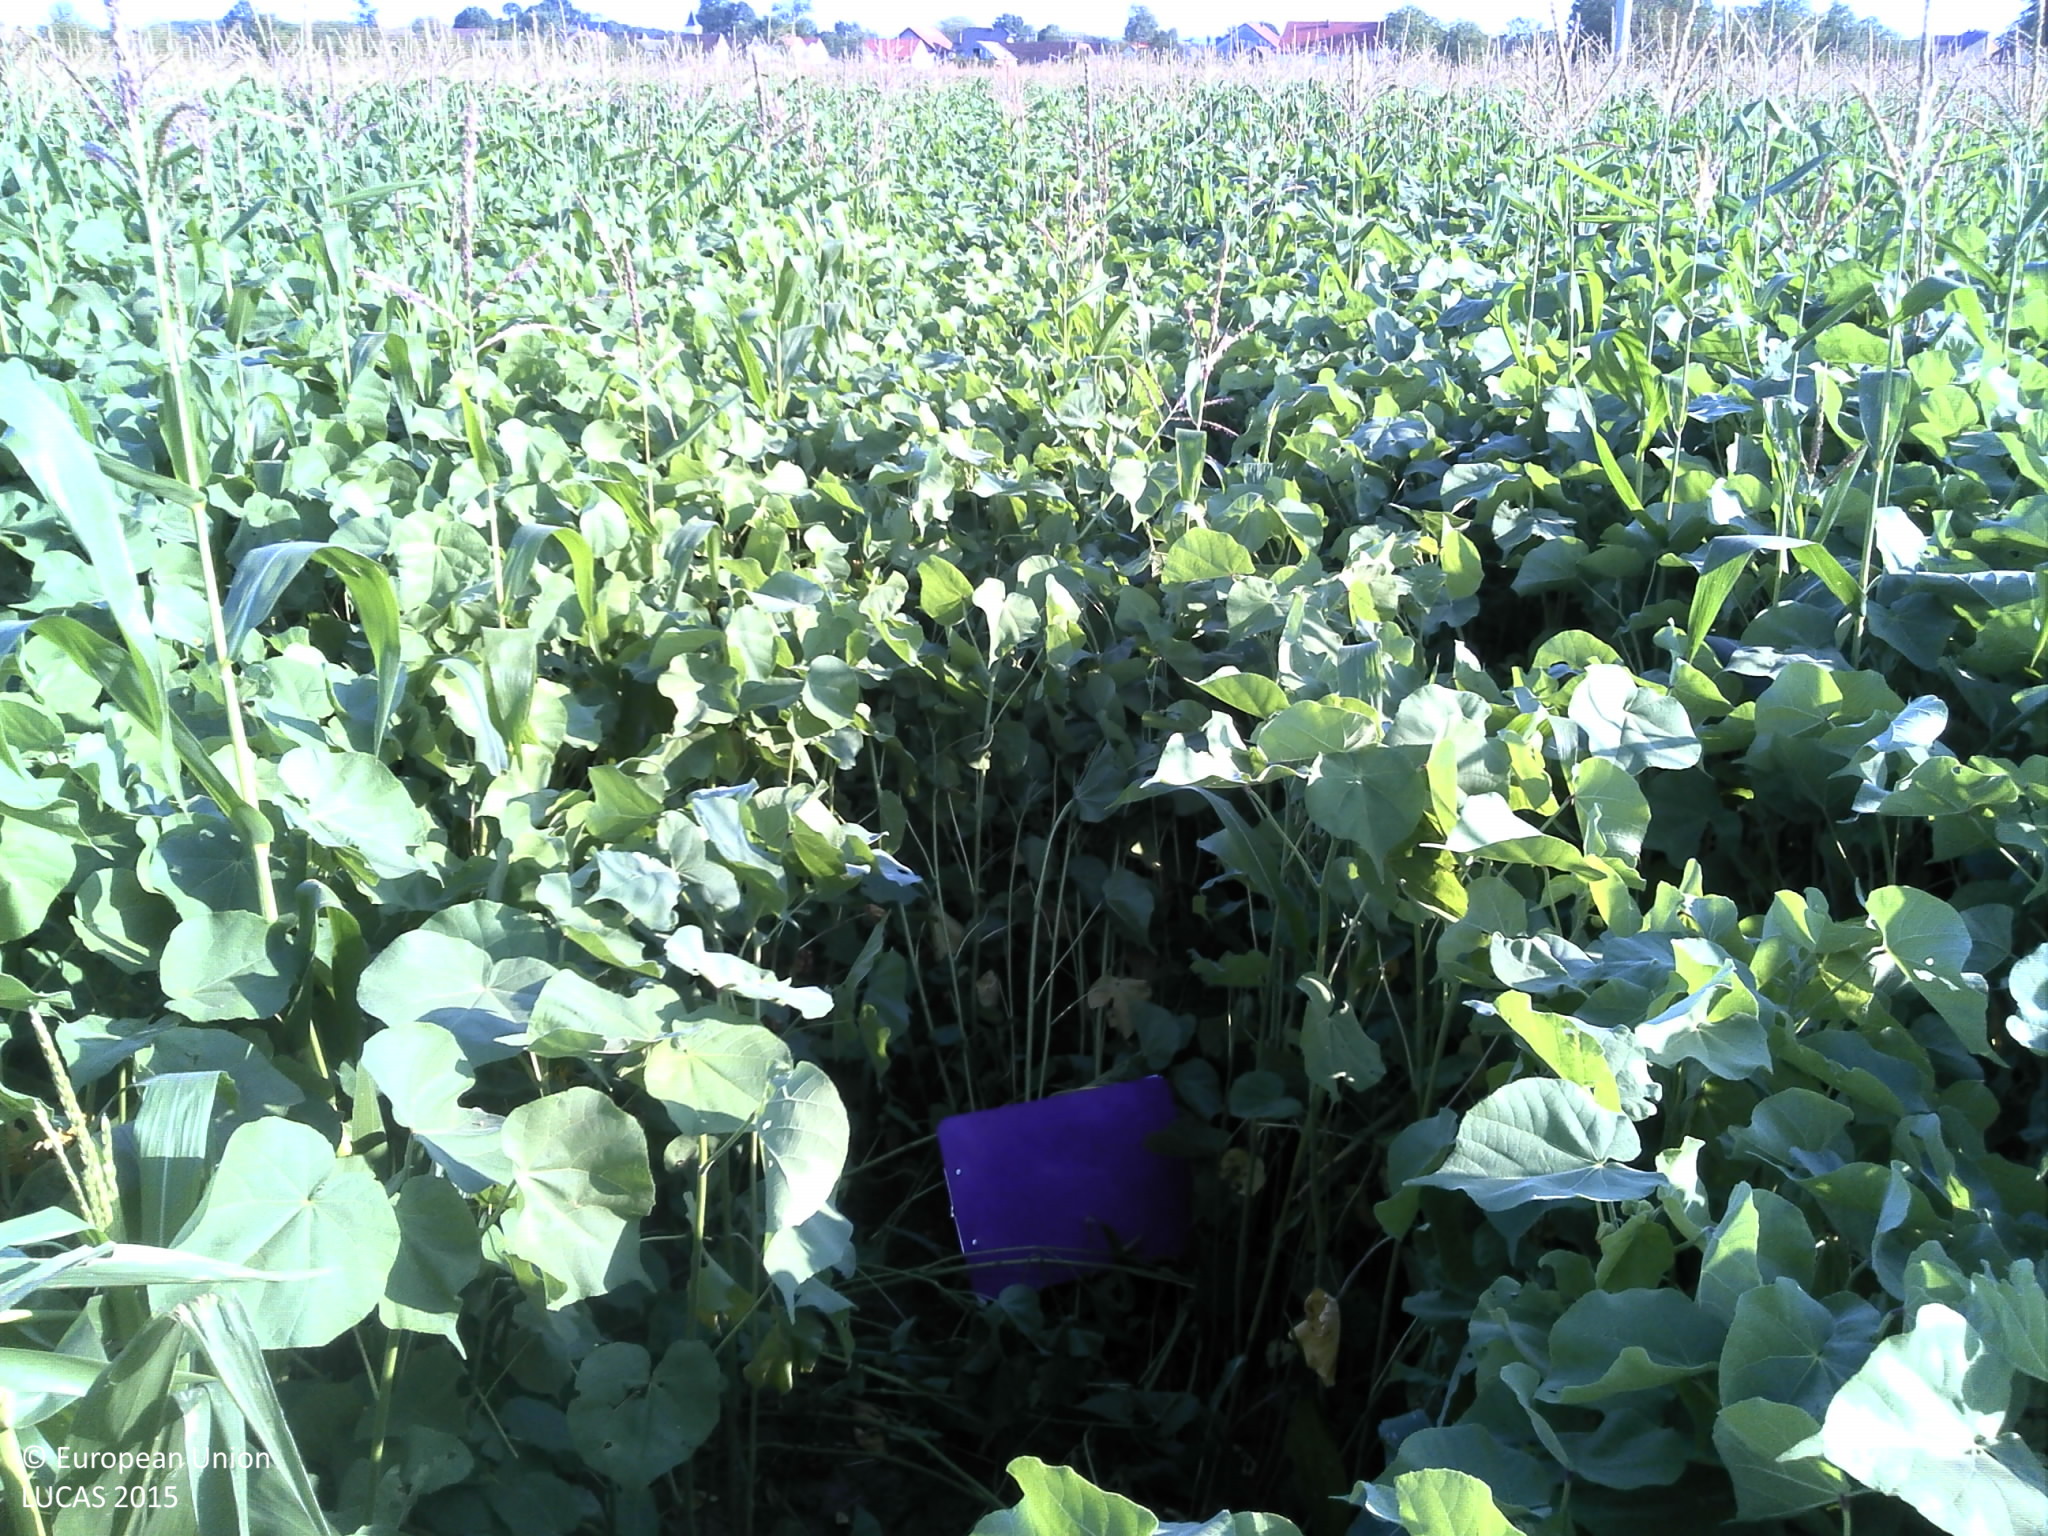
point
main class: Cropland
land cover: Maize
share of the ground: 25 - 50 %
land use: Agriculture (excluding fallow land and kitchen gardens)
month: August
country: HR
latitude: 45.1880
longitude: 18.1616
